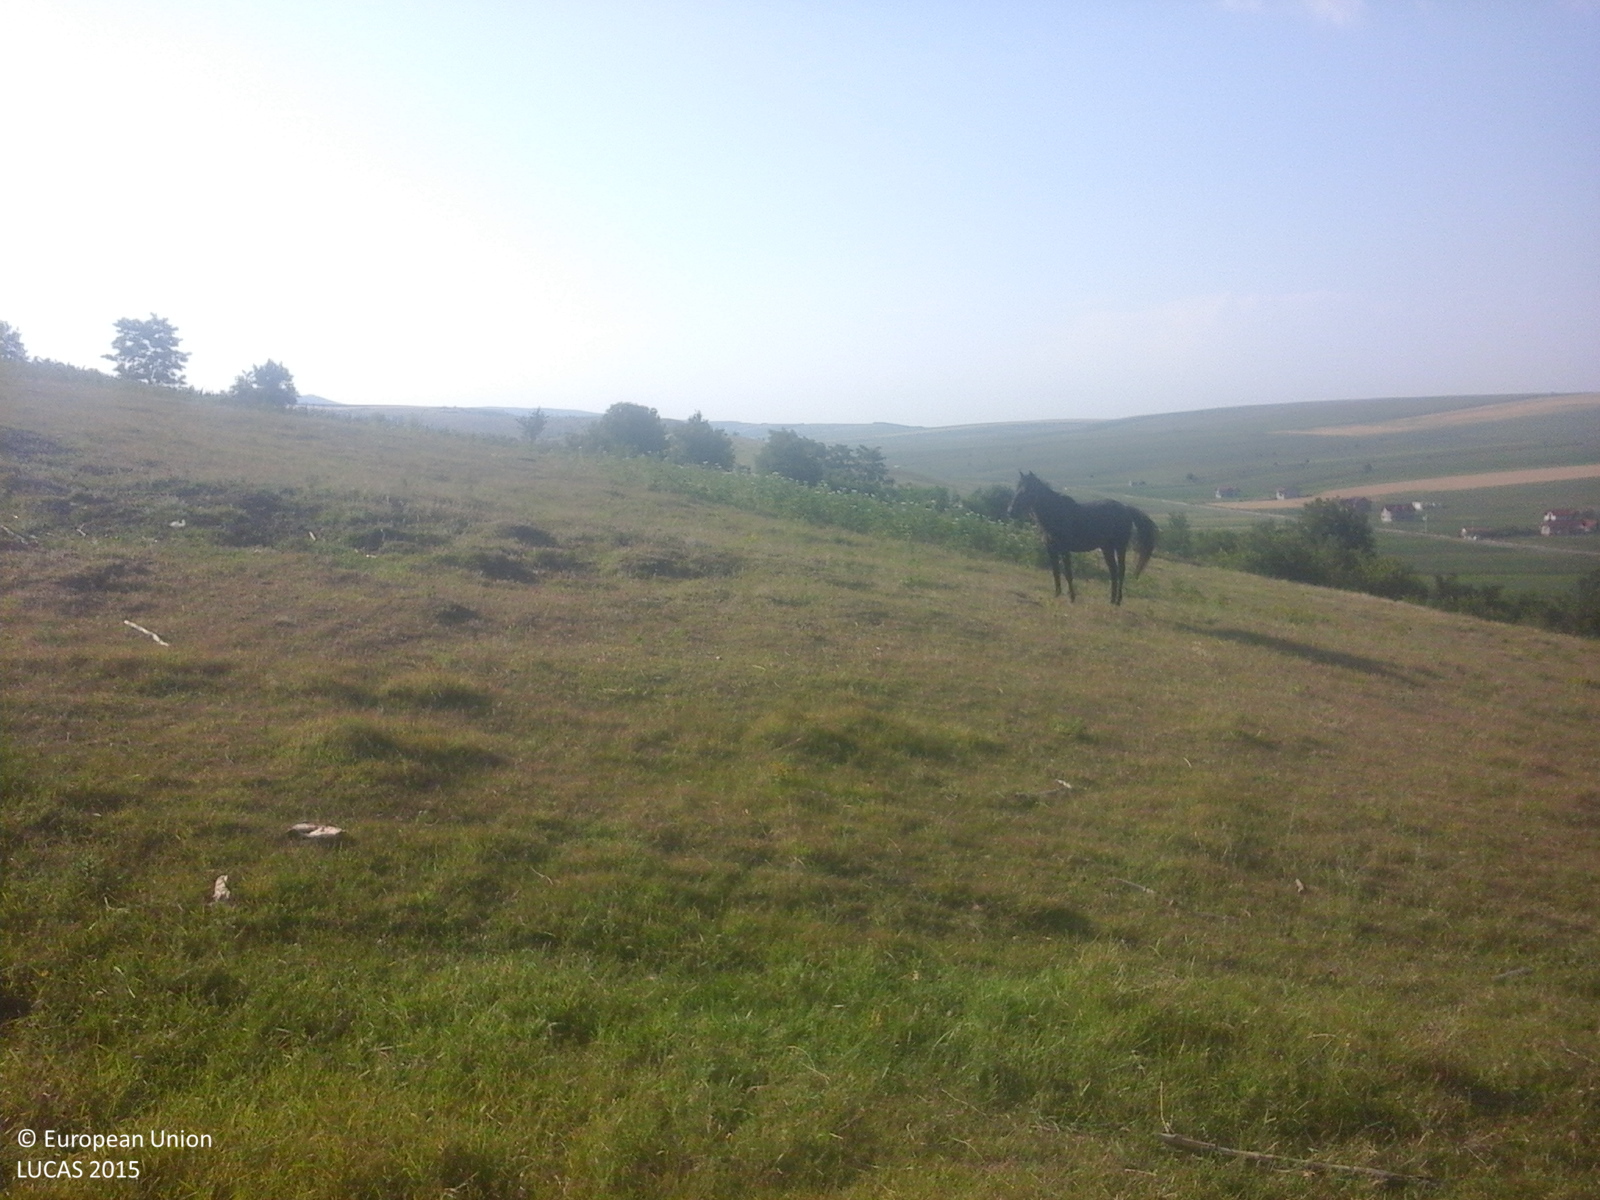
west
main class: Grassland
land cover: Grassland without tree/shrub cover
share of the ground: > 75 %
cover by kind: herbaceous plants 100 %
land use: Agriculture (excluding fallow land and kitchen gardens)
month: June
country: RO
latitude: 46.6962
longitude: 27.7347
